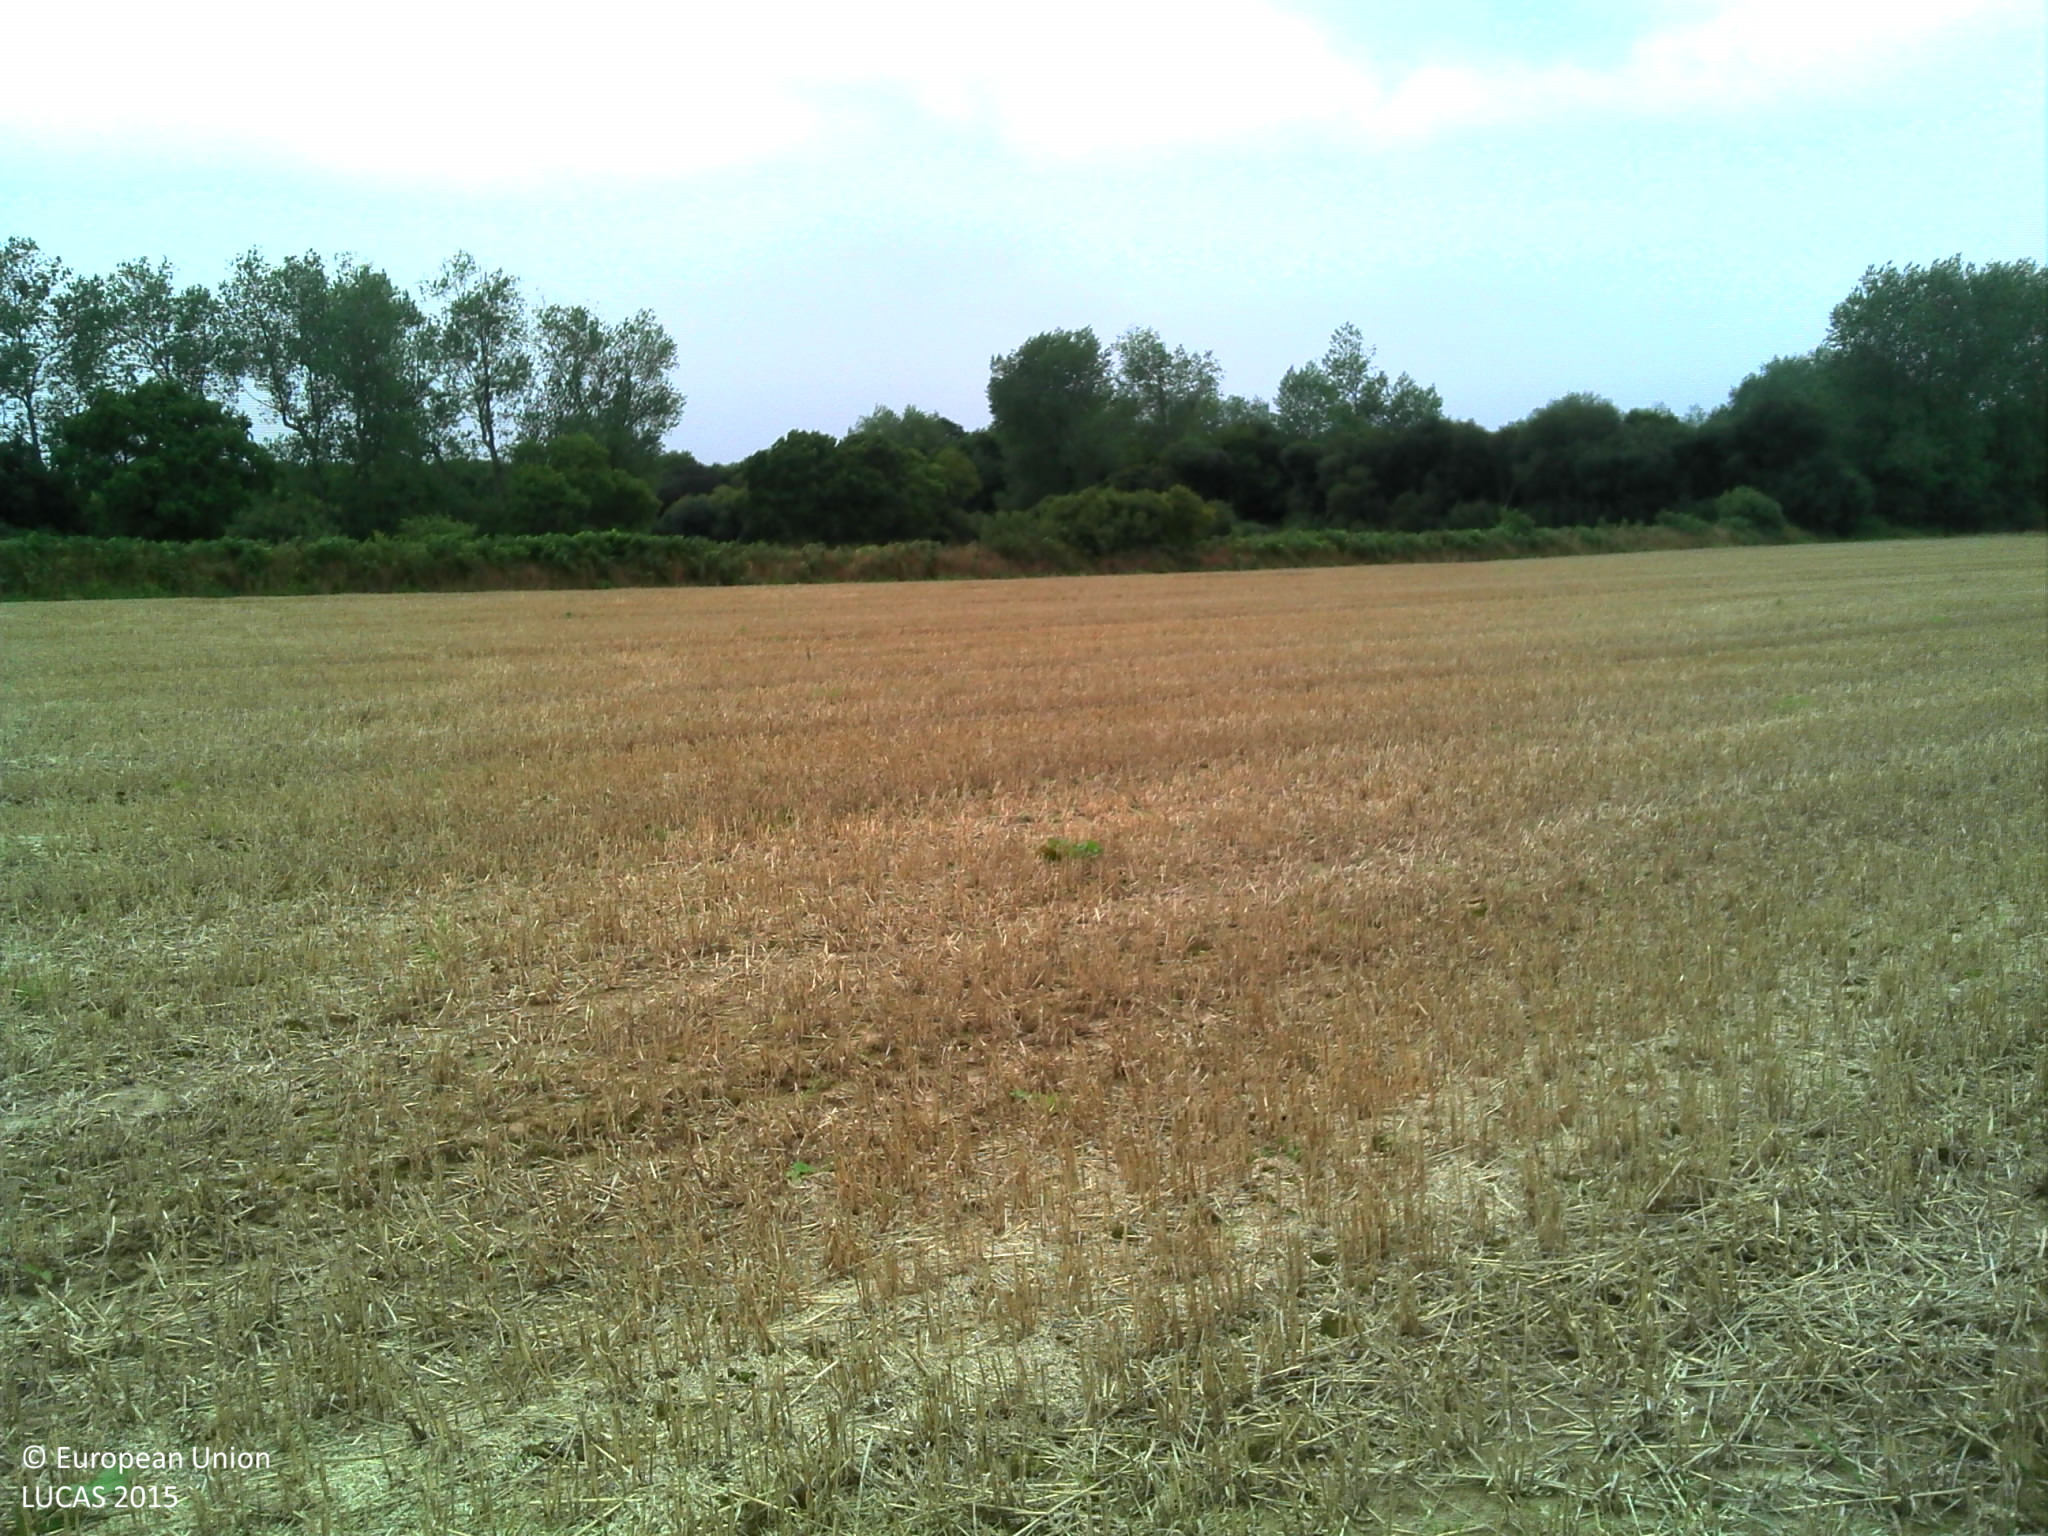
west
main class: Cropland
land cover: Common wheat
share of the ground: 50 - 75 %
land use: Agriculture (excluding fallow land and kitchen gardens)
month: August
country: FR
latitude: 48.8060
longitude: -3.2419
